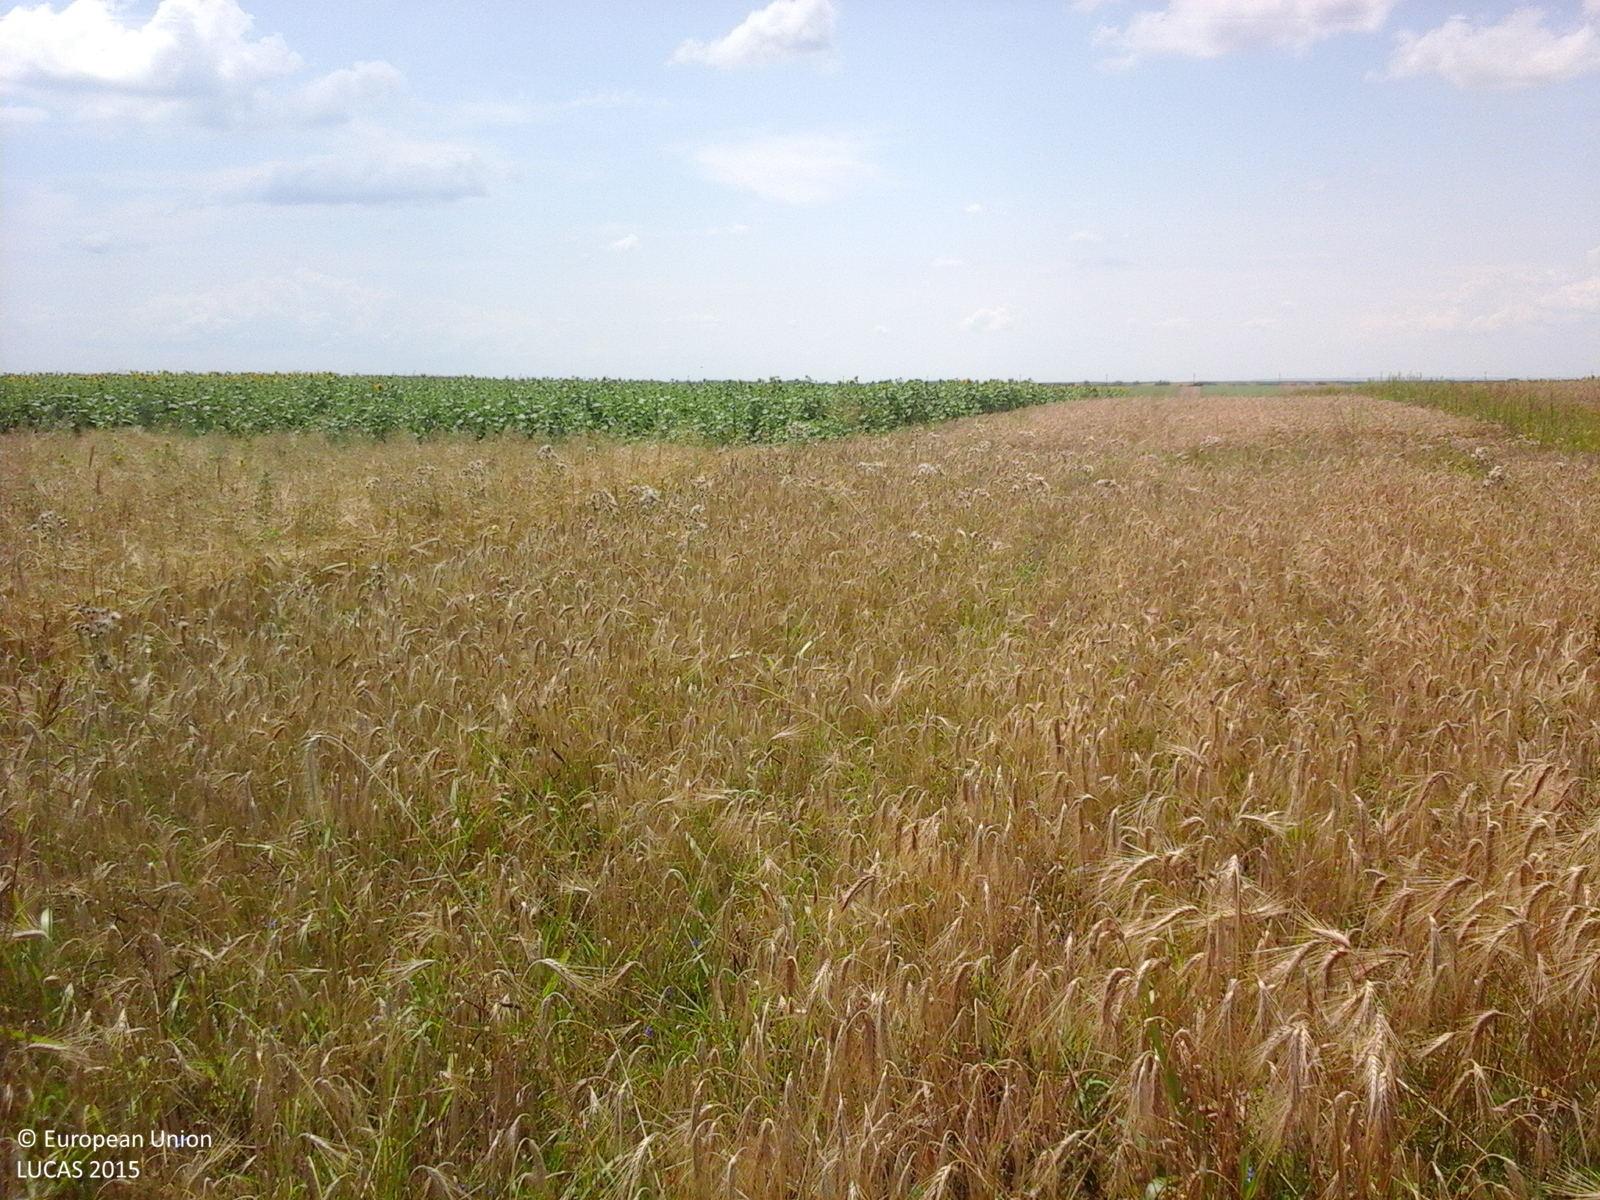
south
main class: Cropland
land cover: Barley
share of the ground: > 75 %
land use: Agriculture (excluding fallow land and kitchen gardens)
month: July
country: RO
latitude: 43.9489
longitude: 24.1014
